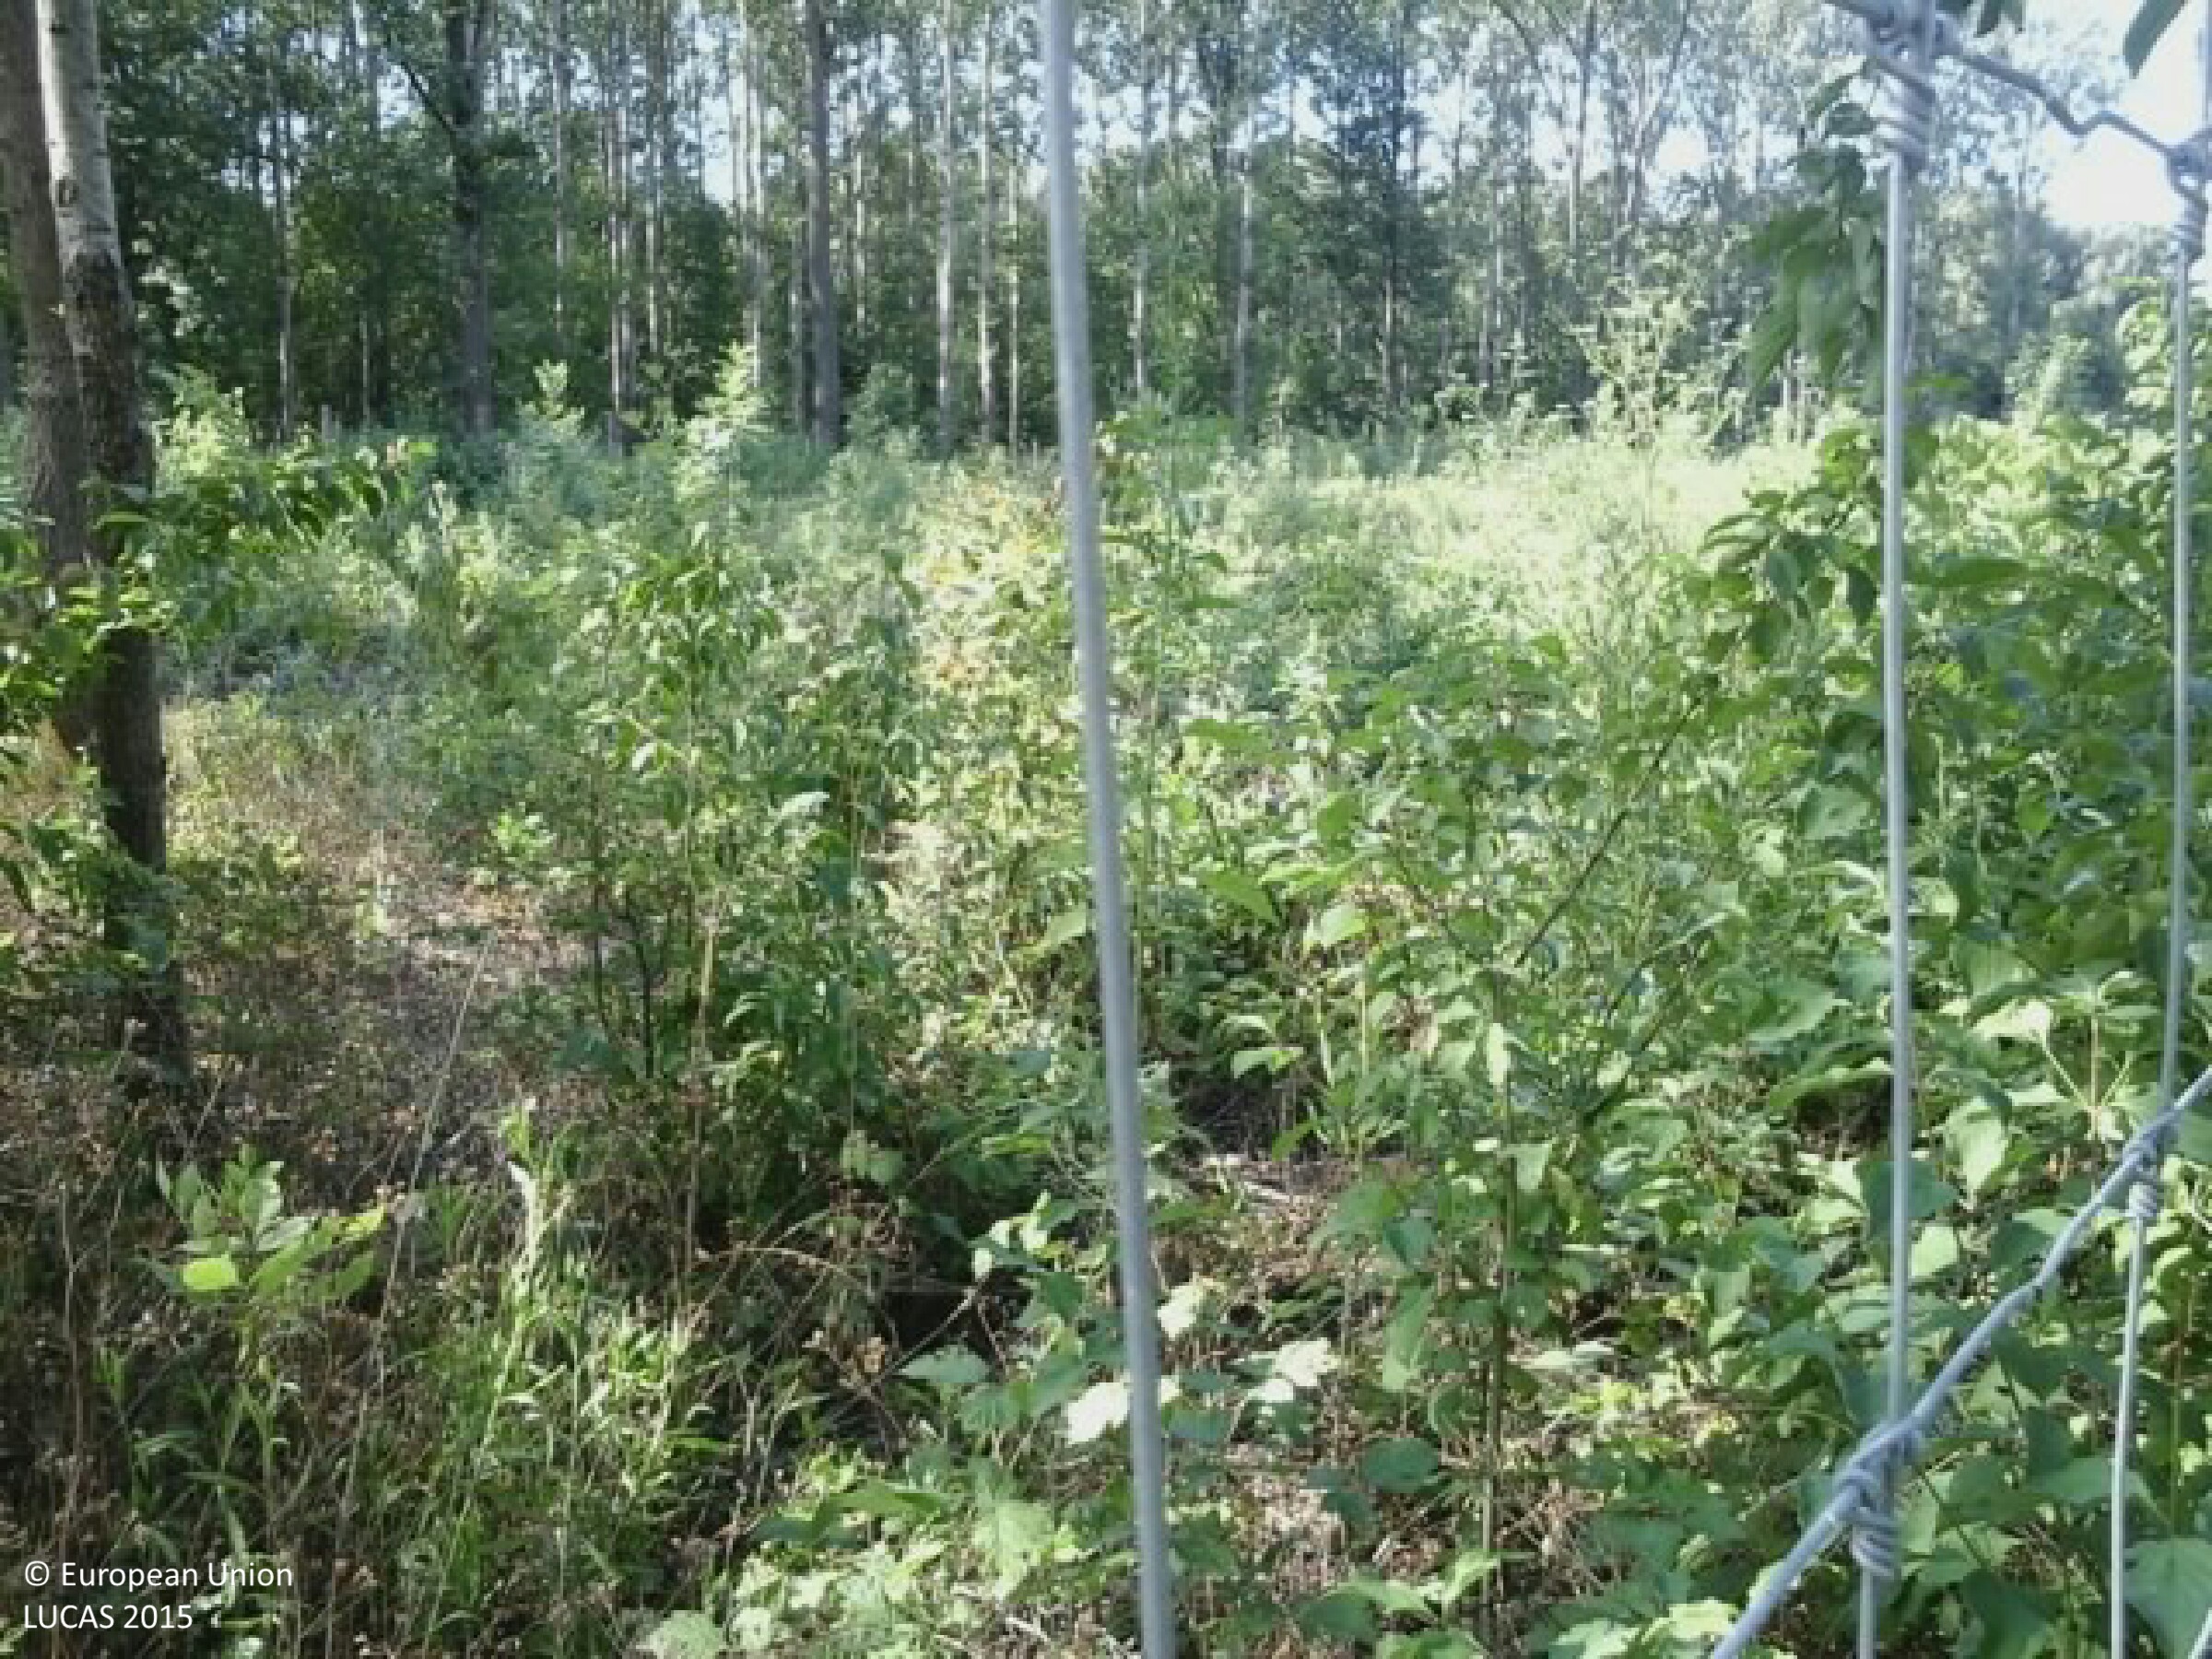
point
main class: Woodland
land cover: Broadleaved woodland
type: mesophytic deciduous forest
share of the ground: 25 - 50 %
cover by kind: broadleaved forest trees 60 %, herbaceous plants 25 %, shrubs 15 %
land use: Forestry
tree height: < 5 m
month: July
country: HU
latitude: 46.3252
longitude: 18.8834
